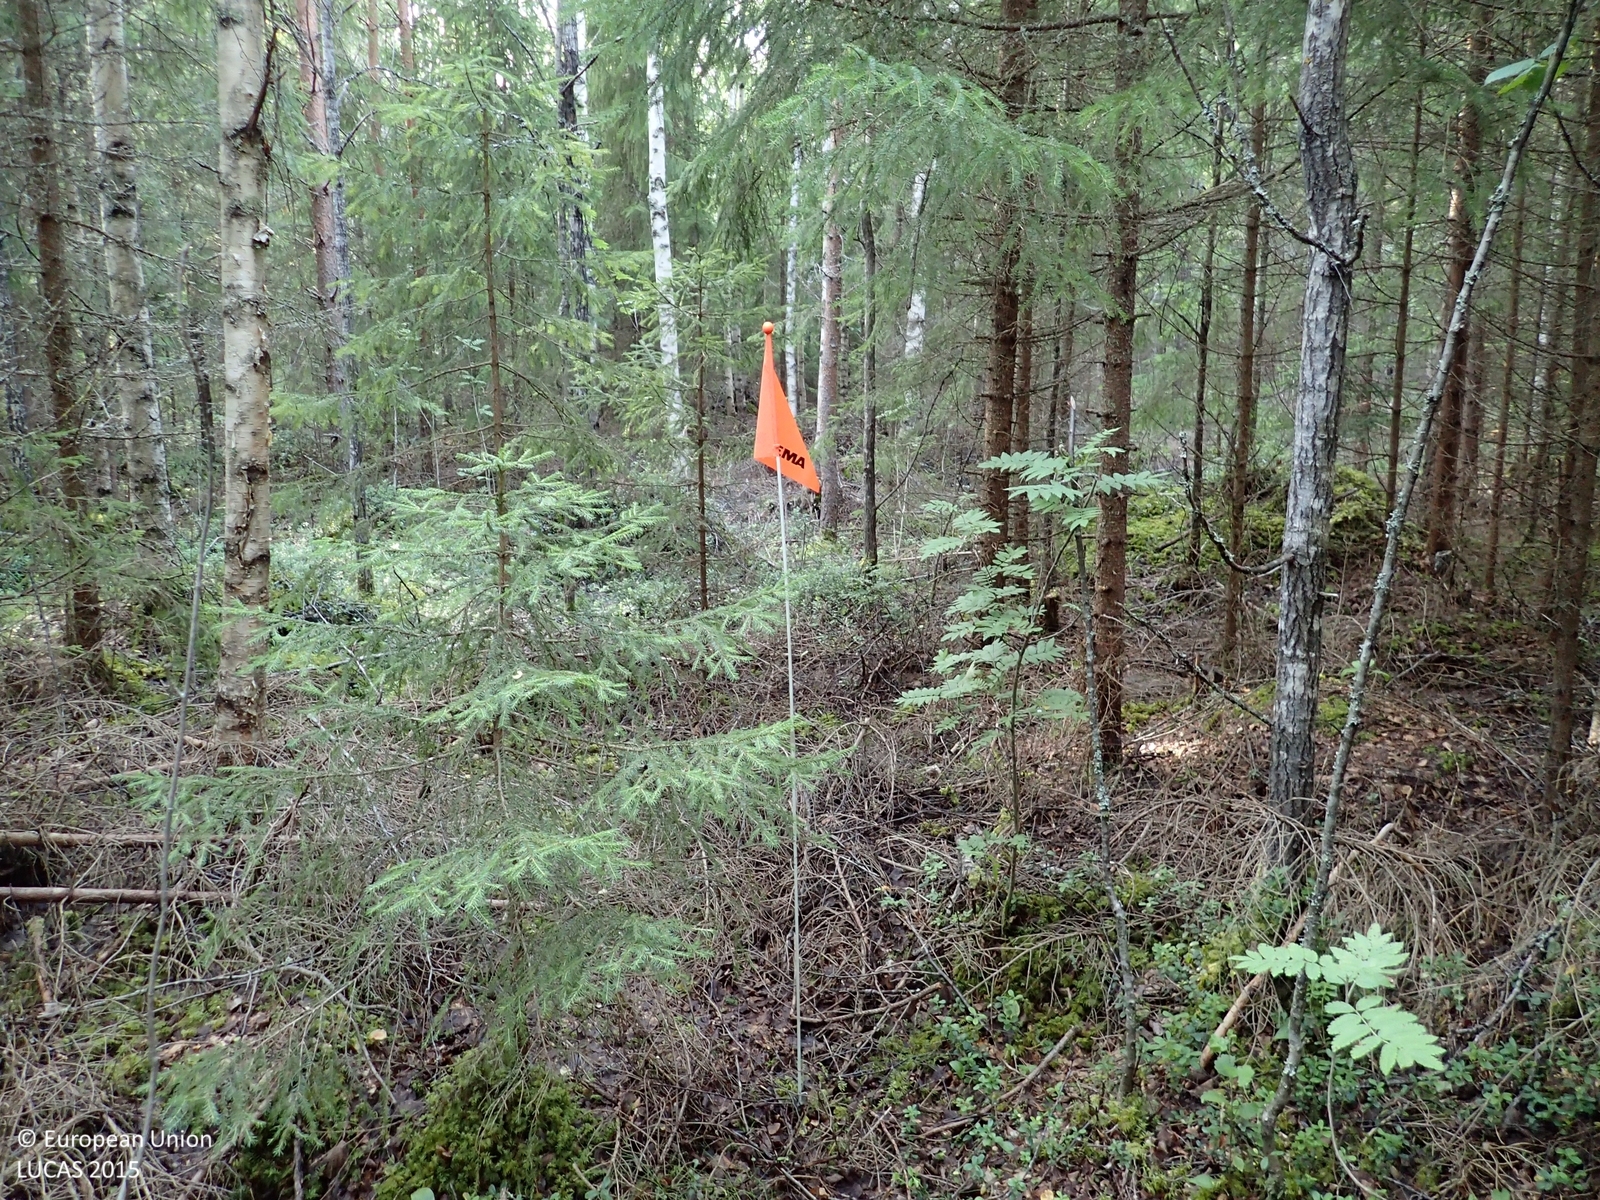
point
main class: Woodland
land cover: Spruce dominated mixed woodland
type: boreal forest
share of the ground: > 75 %
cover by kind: coniferous forest trees 60 %, broadleaved forest trees 20 %, shrubs 15 %, lichens and mosses 5 %
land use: Forestry
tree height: > 5 m
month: July
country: FI
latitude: 62.9554
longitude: 21.9719
